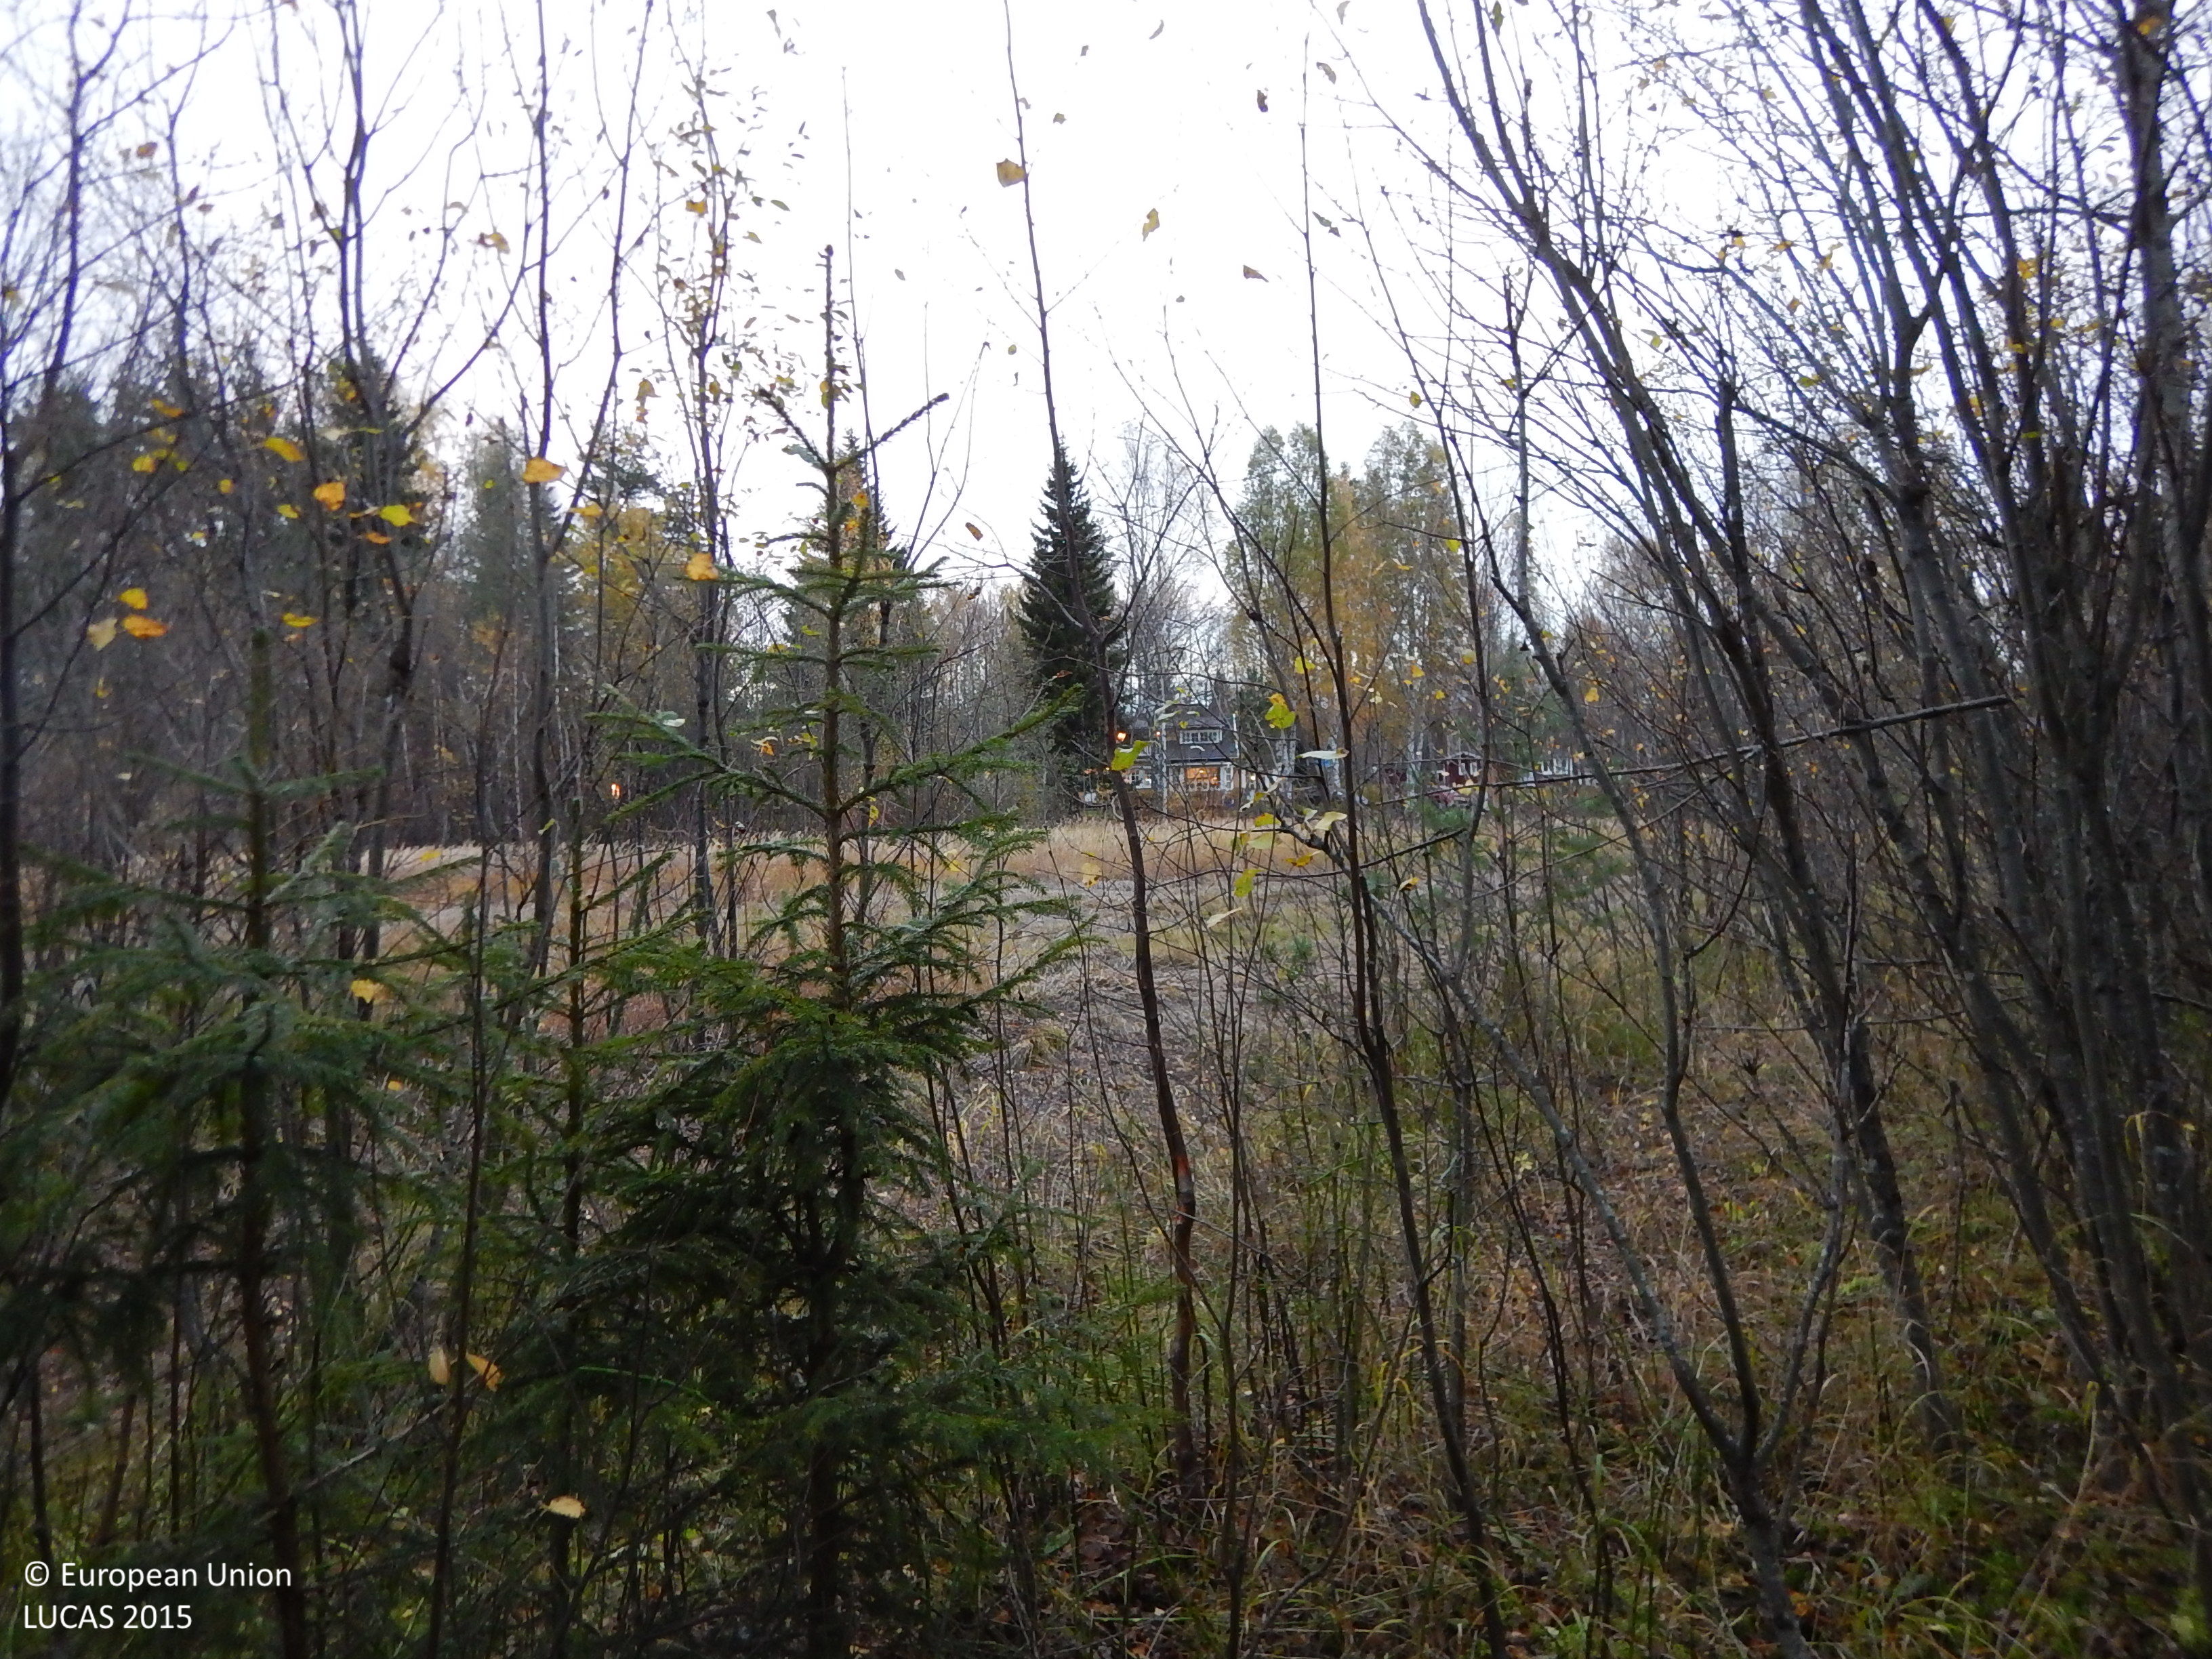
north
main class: Woodland
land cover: Broadleaved woodland
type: non-riverine alder, birch or aspen forest
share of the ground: 50 - 75 %
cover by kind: broadleaved forest trees 55 %, shrubs 20 %, herbaceous plants 10 %, lichens and mosses 10 %, coniferous forest trees 5 %
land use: Semi-natural and natural areas not in use
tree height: > 5 m
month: October
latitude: 64.8548
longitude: 21.0086
